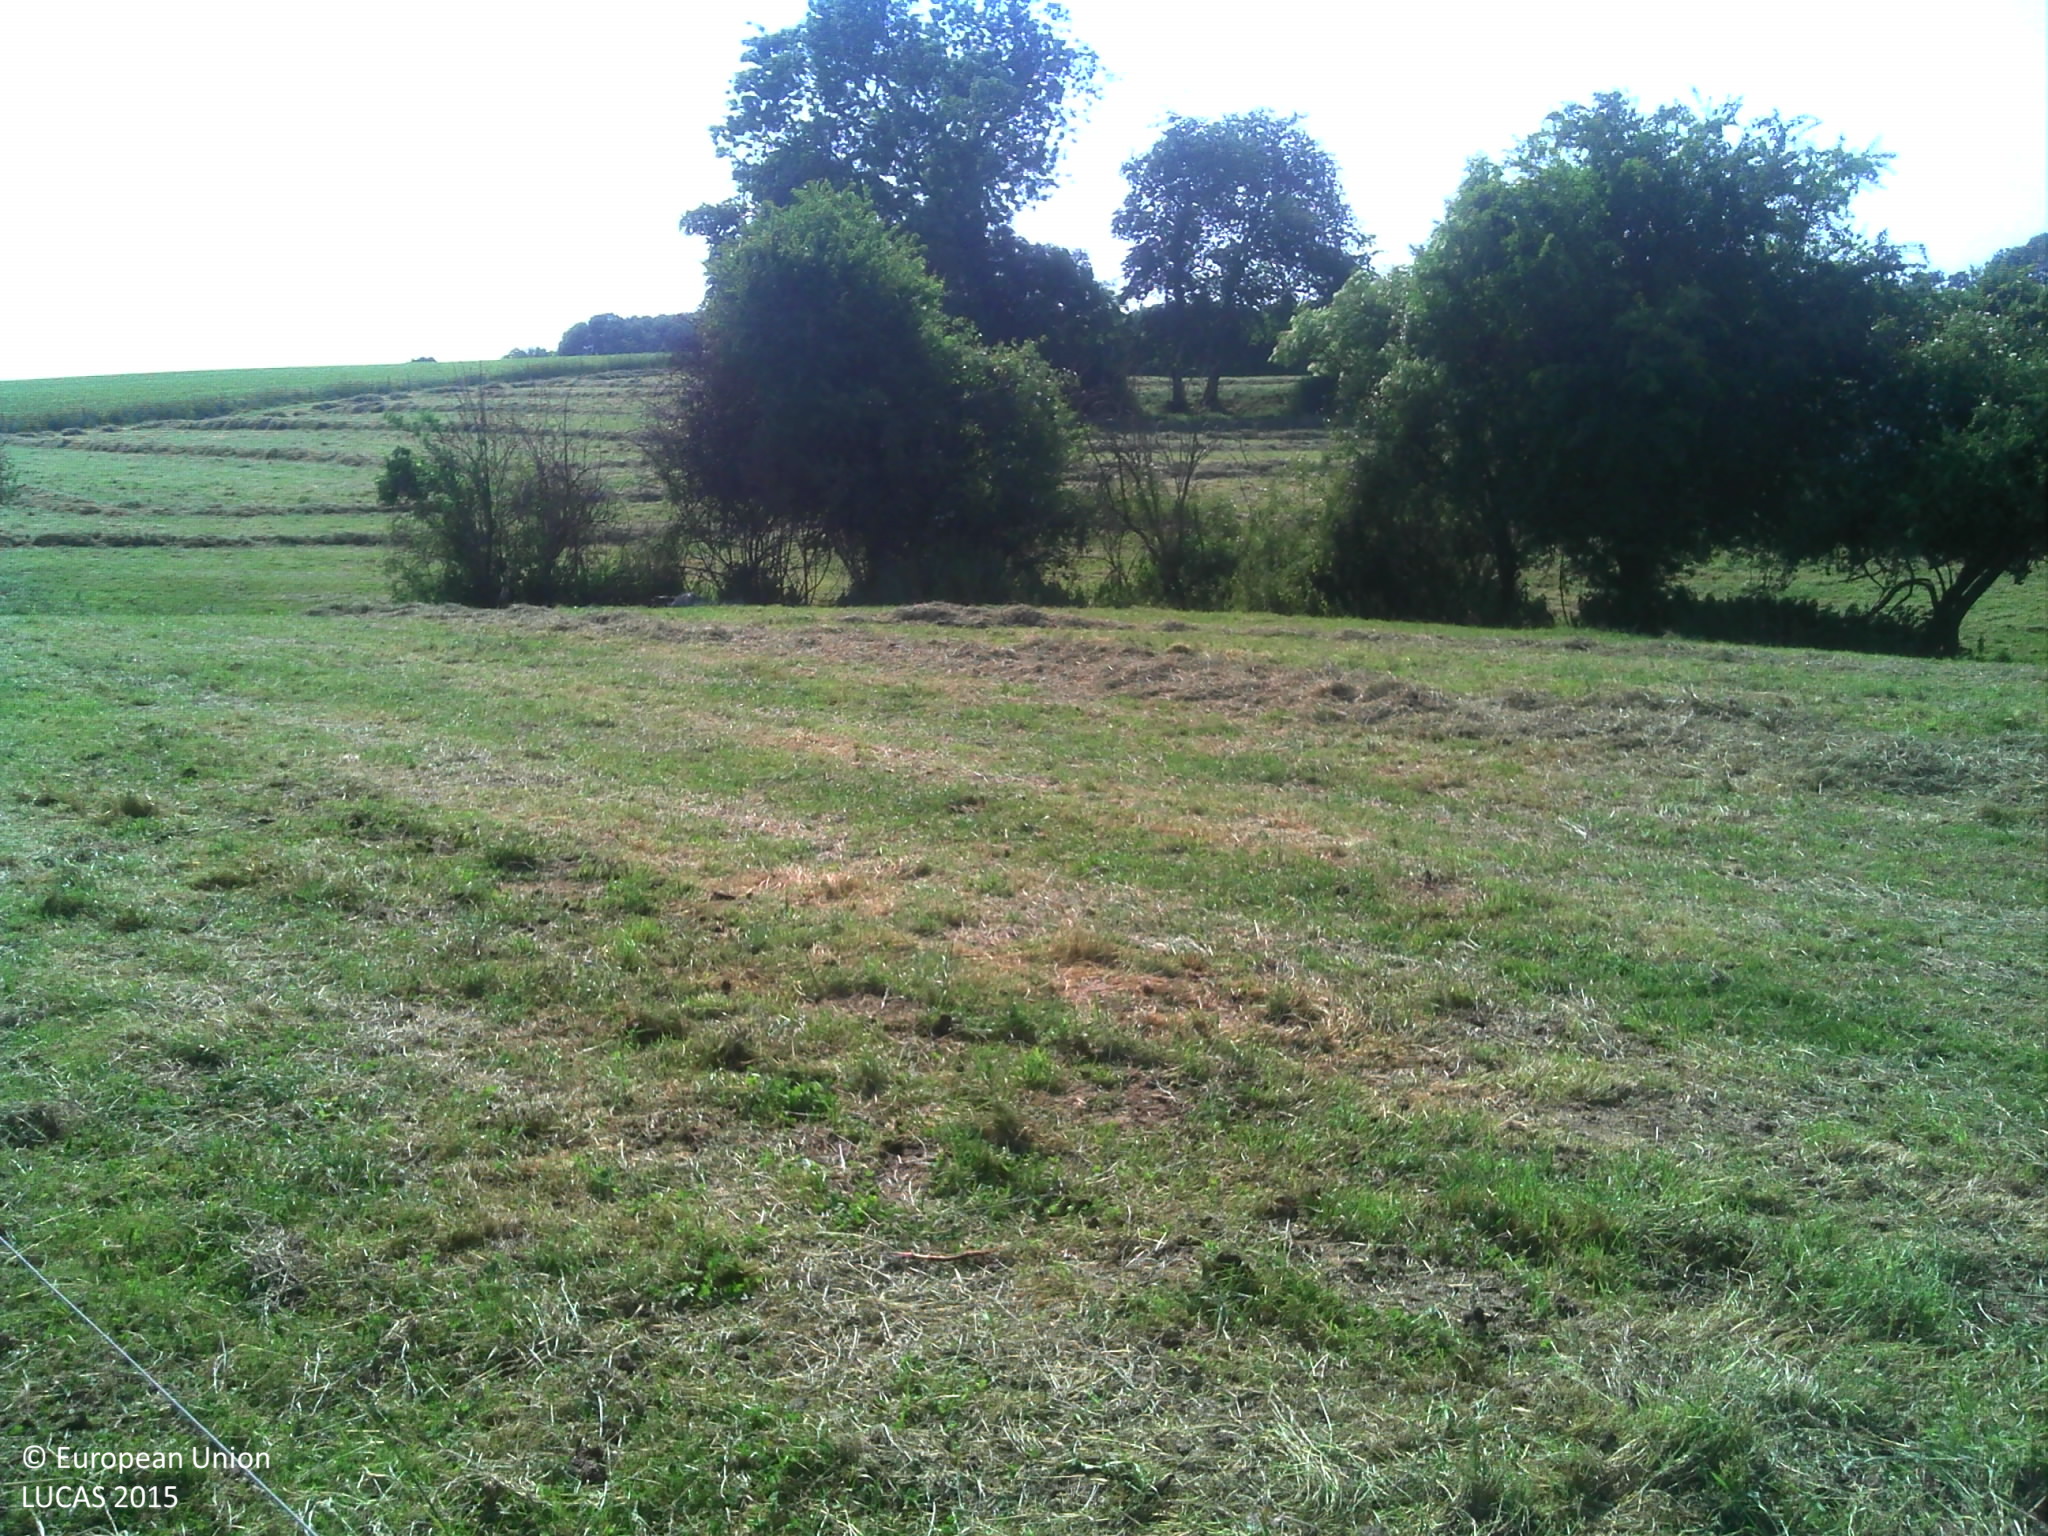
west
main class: Grassland
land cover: Grassland without tree/shrub cover
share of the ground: > 75 %
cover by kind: herbaceous plants 100 %
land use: Agriculture (excluding fallow land and kitchen gardens)
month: June
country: FR
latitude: 49.7593
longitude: 4.0673
